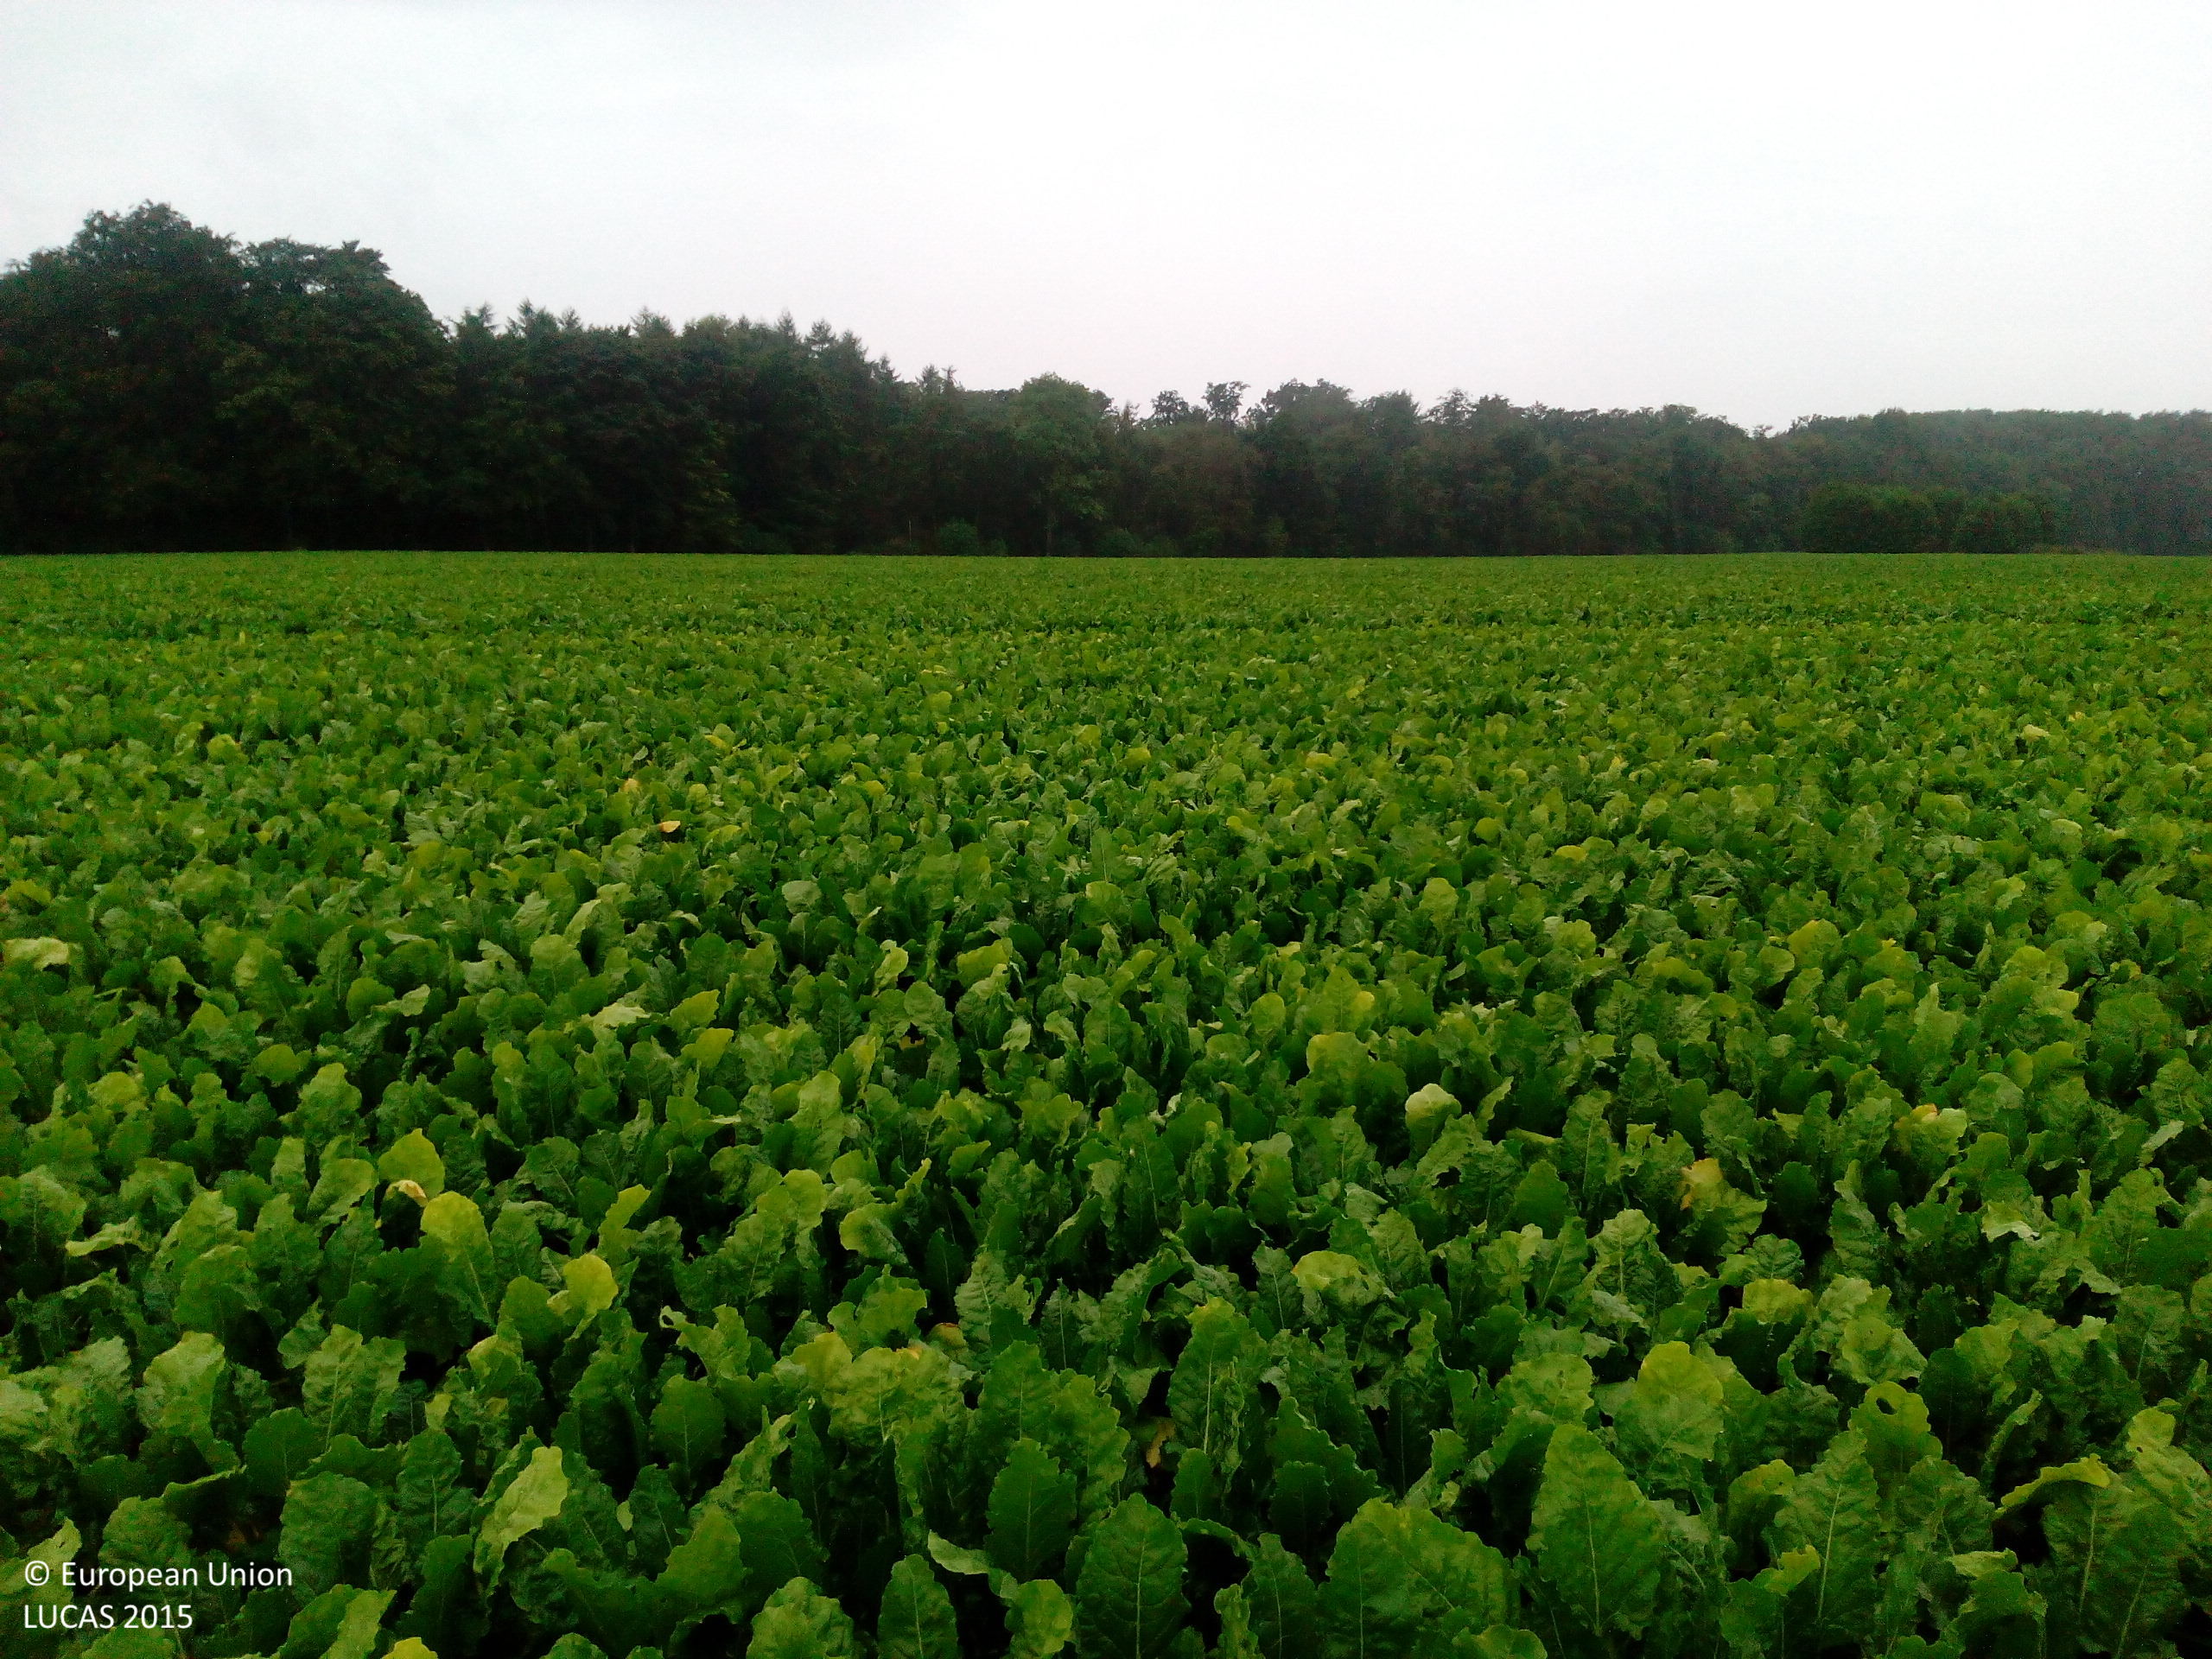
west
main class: Cropland
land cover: Sugar beet
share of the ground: > 75 %
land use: Agriculture (excluding fallow land and kitchen gardens)
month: August
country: DE
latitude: 53.7793
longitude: 9.9242
